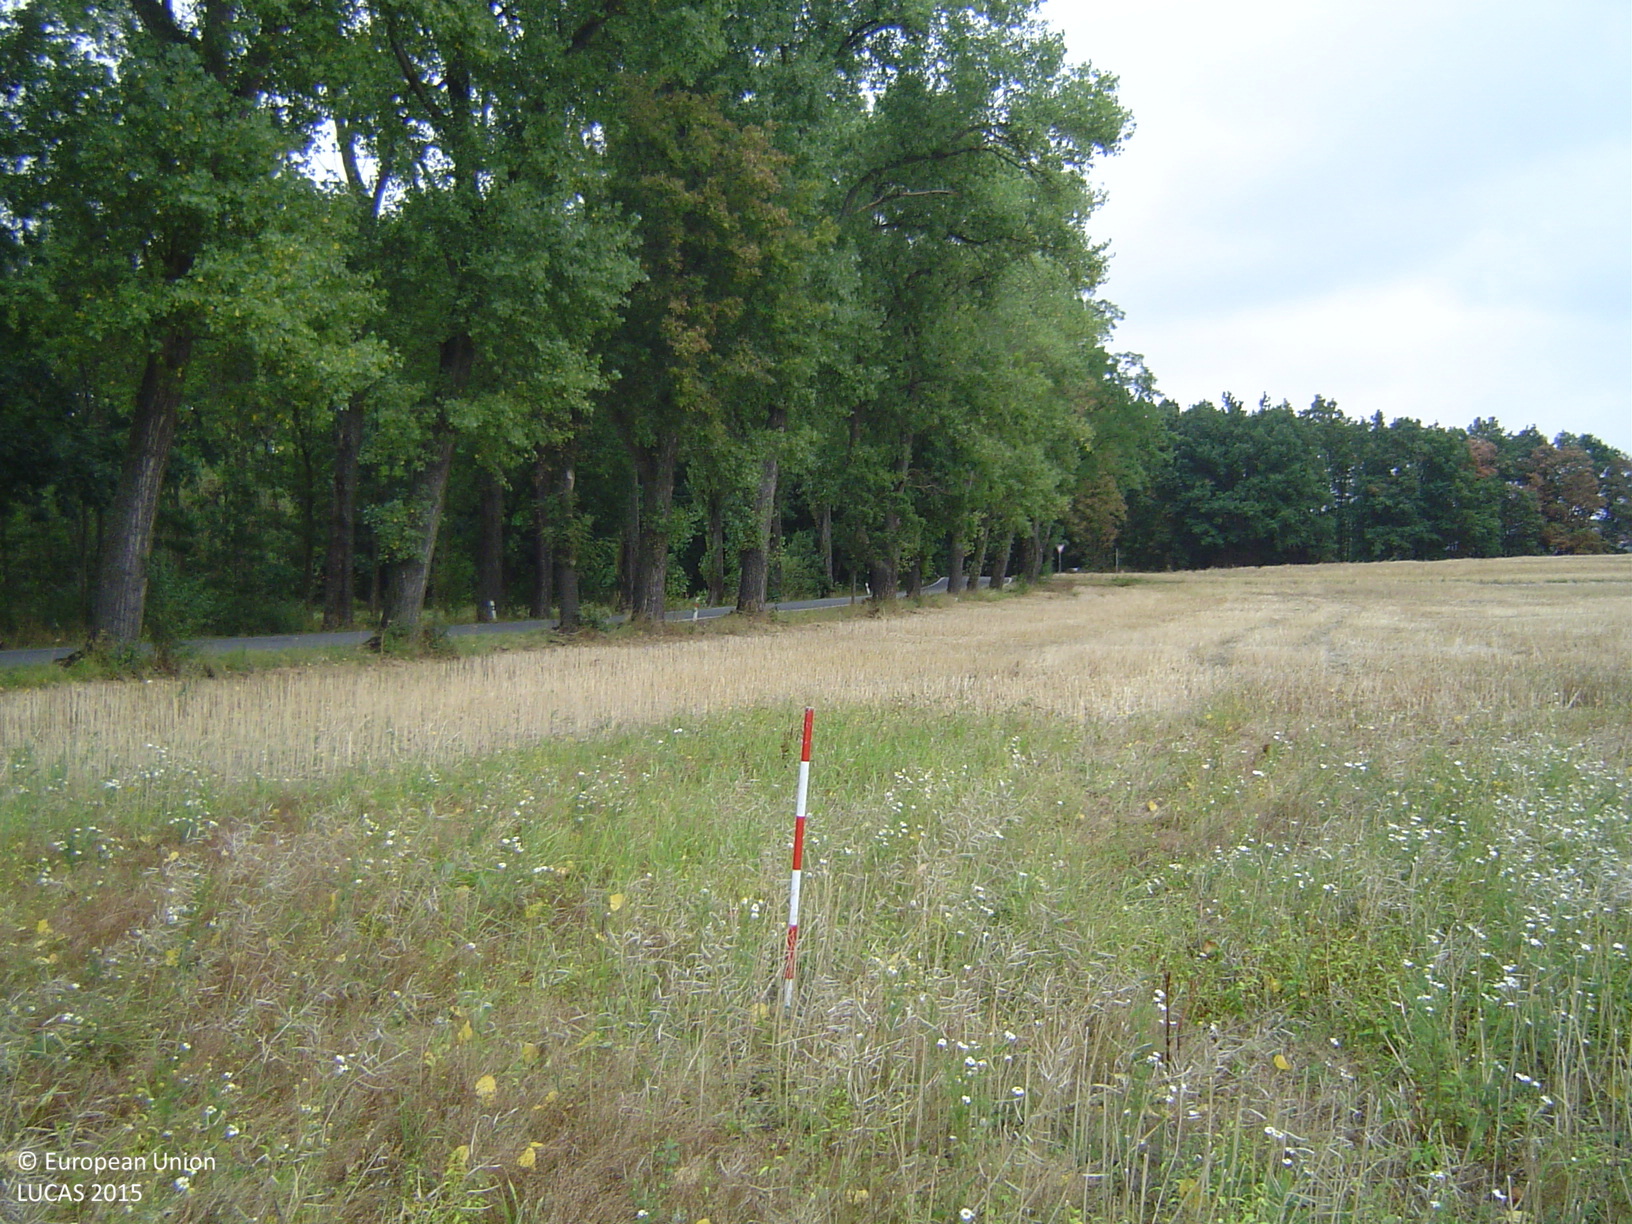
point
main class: Cropland
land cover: Rape and turnip rape
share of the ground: 25 - 50 %
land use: Agriculture (excluding fallow land and kitchen gardens)
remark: Harvested field
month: August
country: CZ
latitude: 49.5750
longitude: 13.9697
